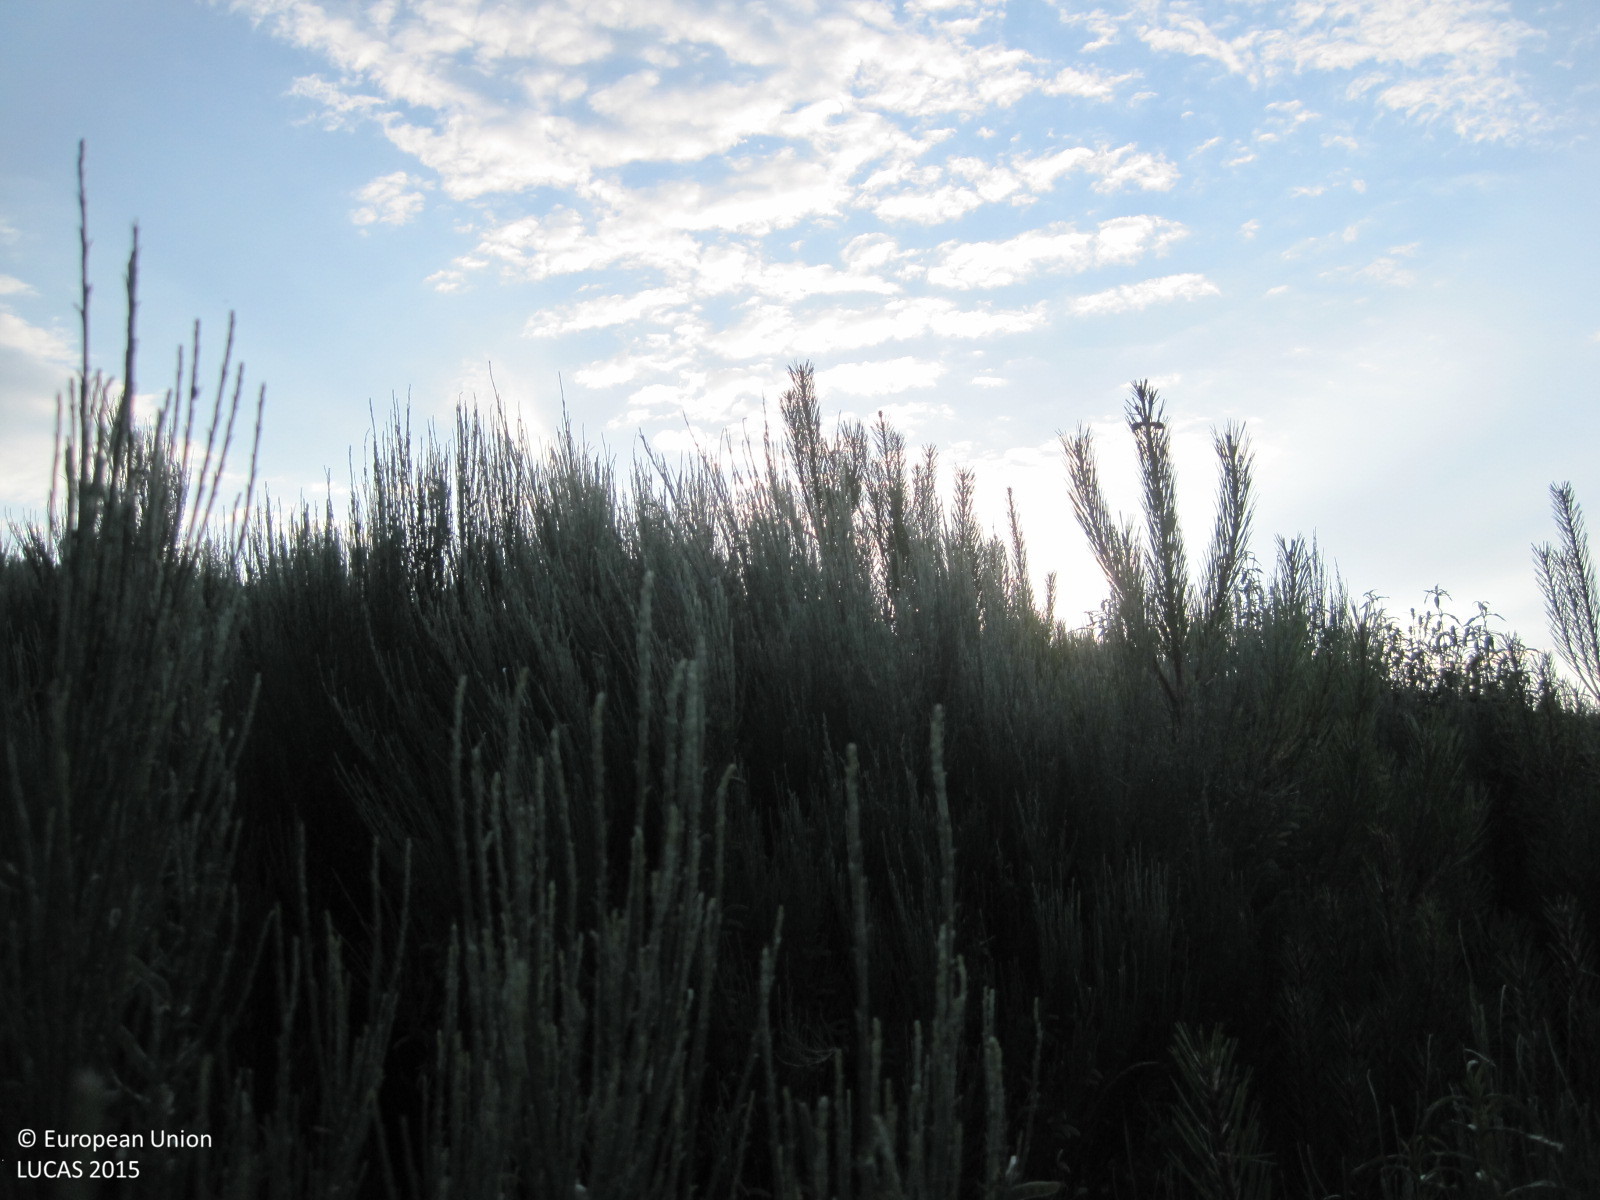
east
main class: Woodland
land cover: Pine dominated coniferous woodland
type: coniferous forest of the mediterranean region
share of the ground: > 75 %
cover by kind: coniferous forest trees 90 %, shrubs 10 %
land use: Forestry
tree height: < 5 m
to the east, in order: Pine dominated coniferous woodland; Rock outcrops; Pine dominated coniferous woodland; Shrubland without tree cover
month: June
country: ES
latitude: 40.2565
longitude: -5.0463
